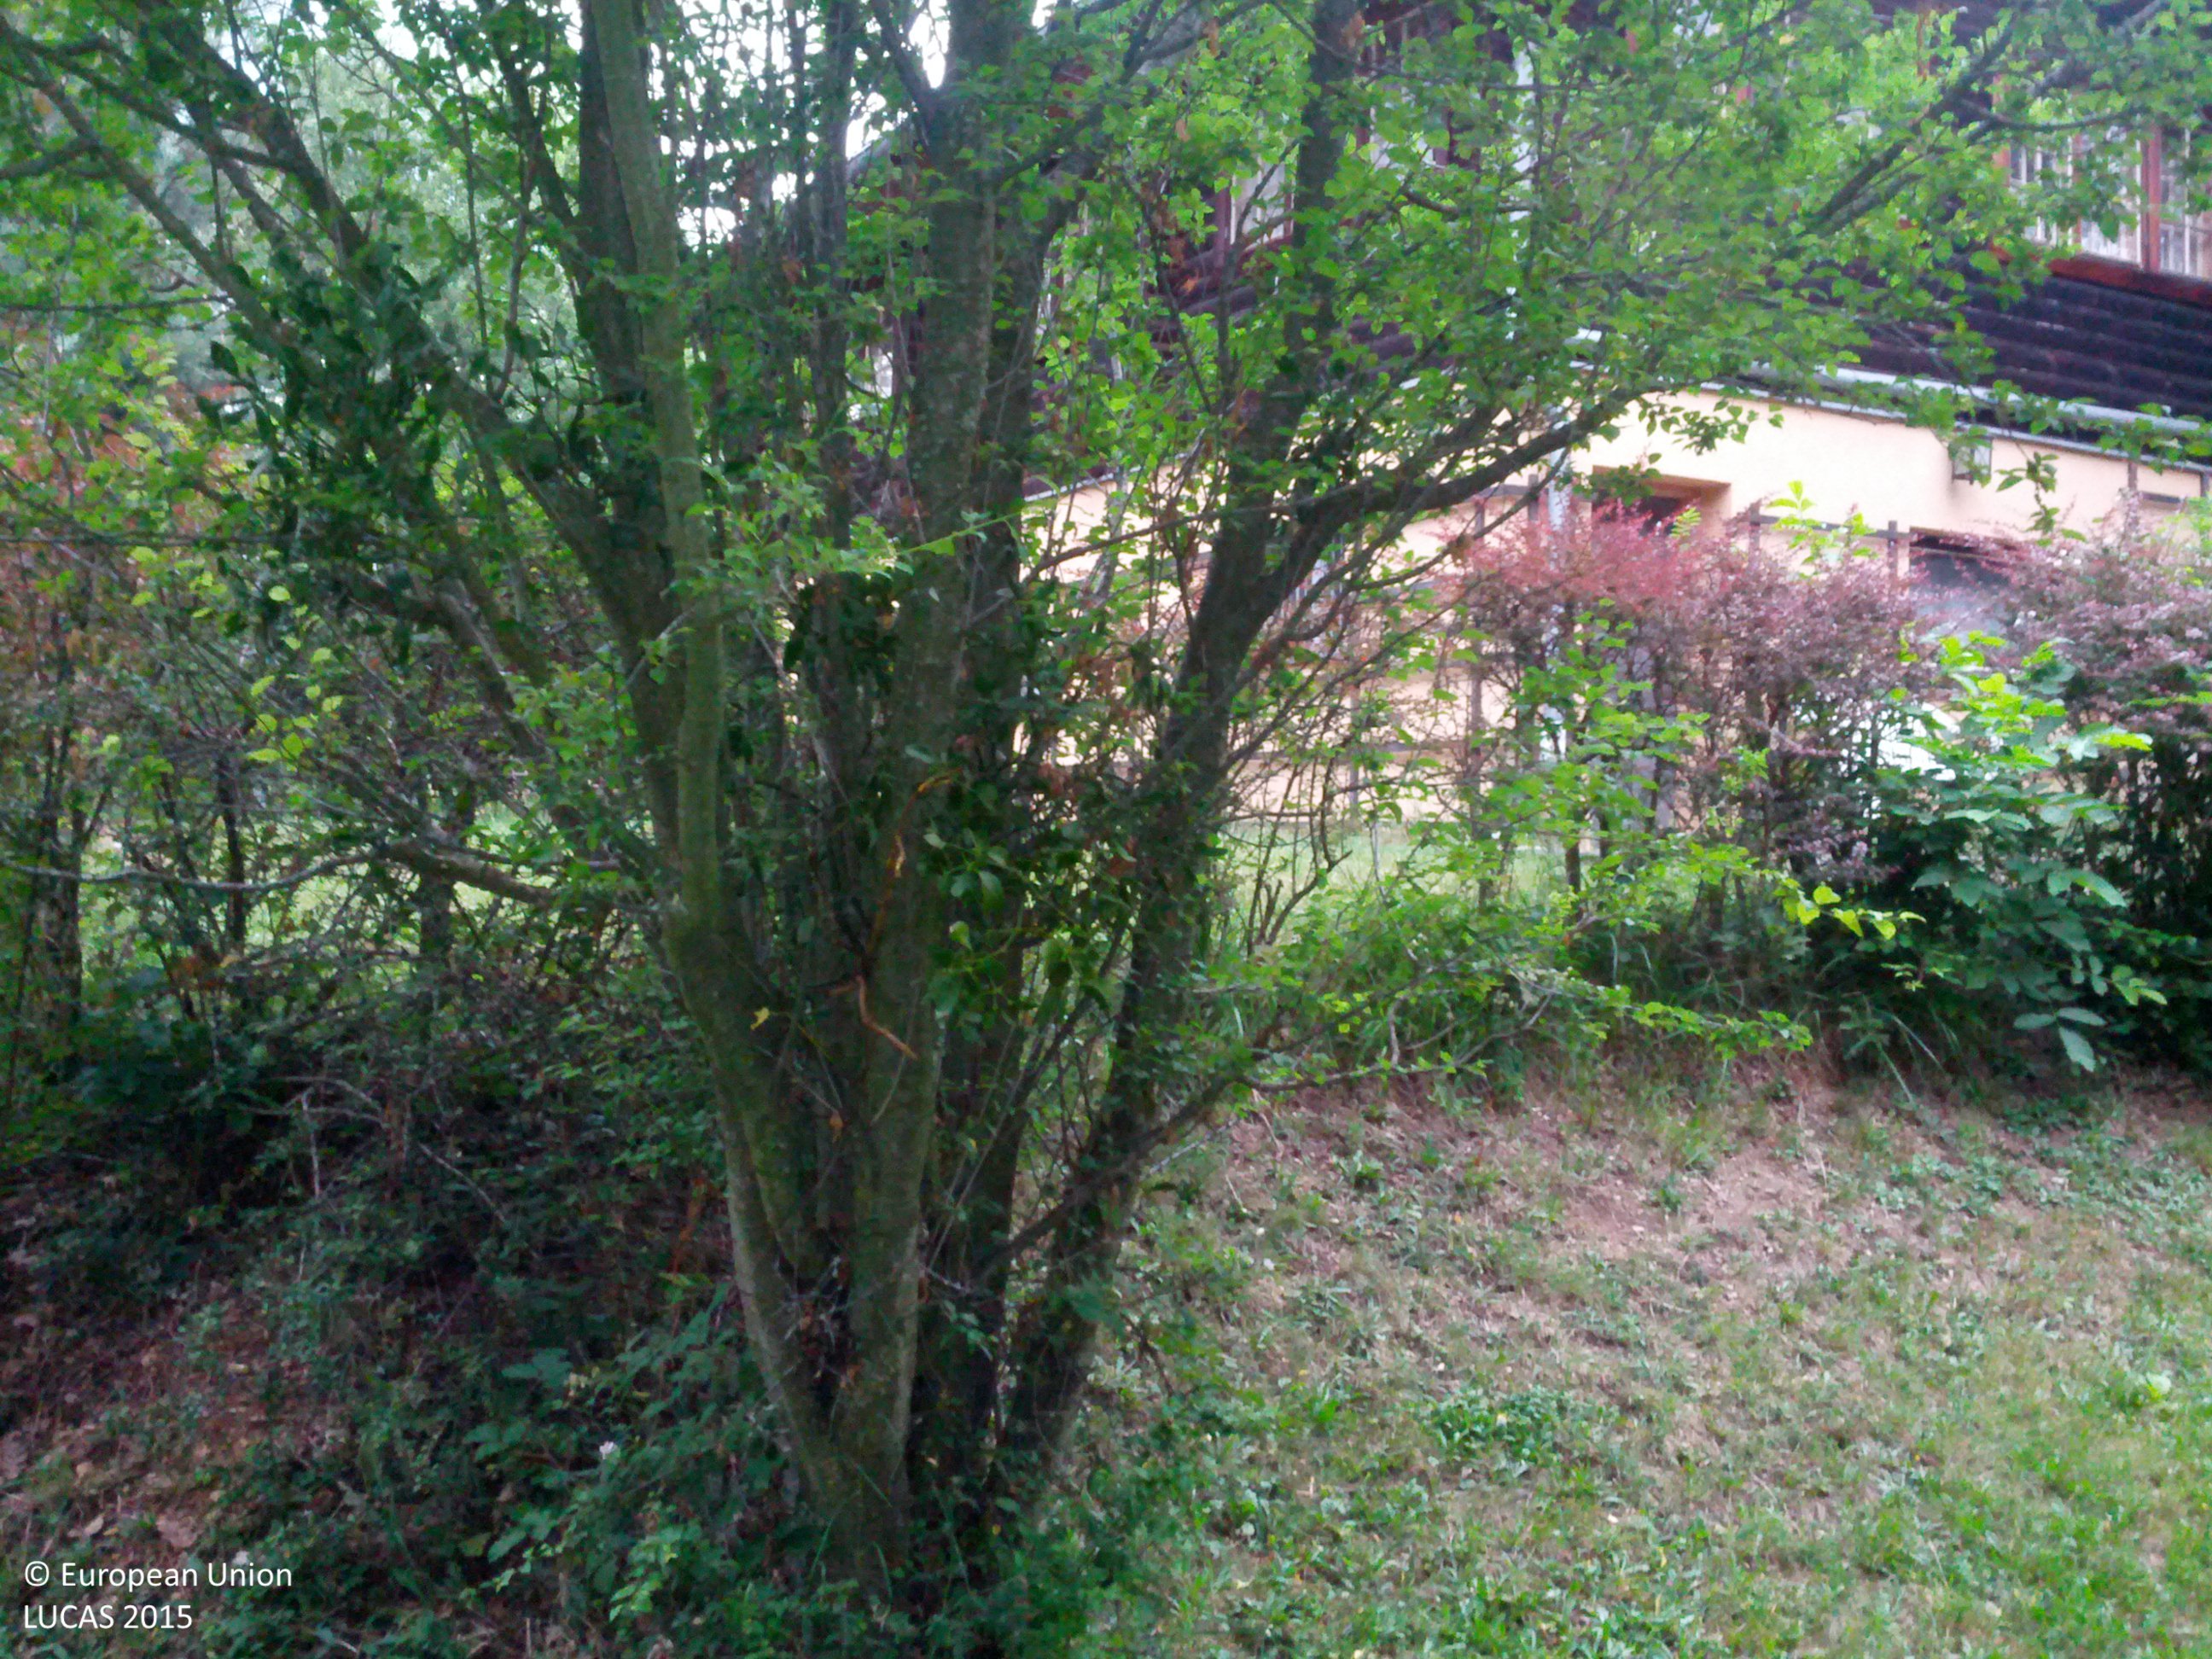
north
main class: Grassland
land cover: Grassland without tree/shrub cover
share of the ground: > 75 %
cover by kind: herbaceous plants 100 %
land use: Residential
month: July
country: AT
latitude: 47.4043
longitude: 16.1111
